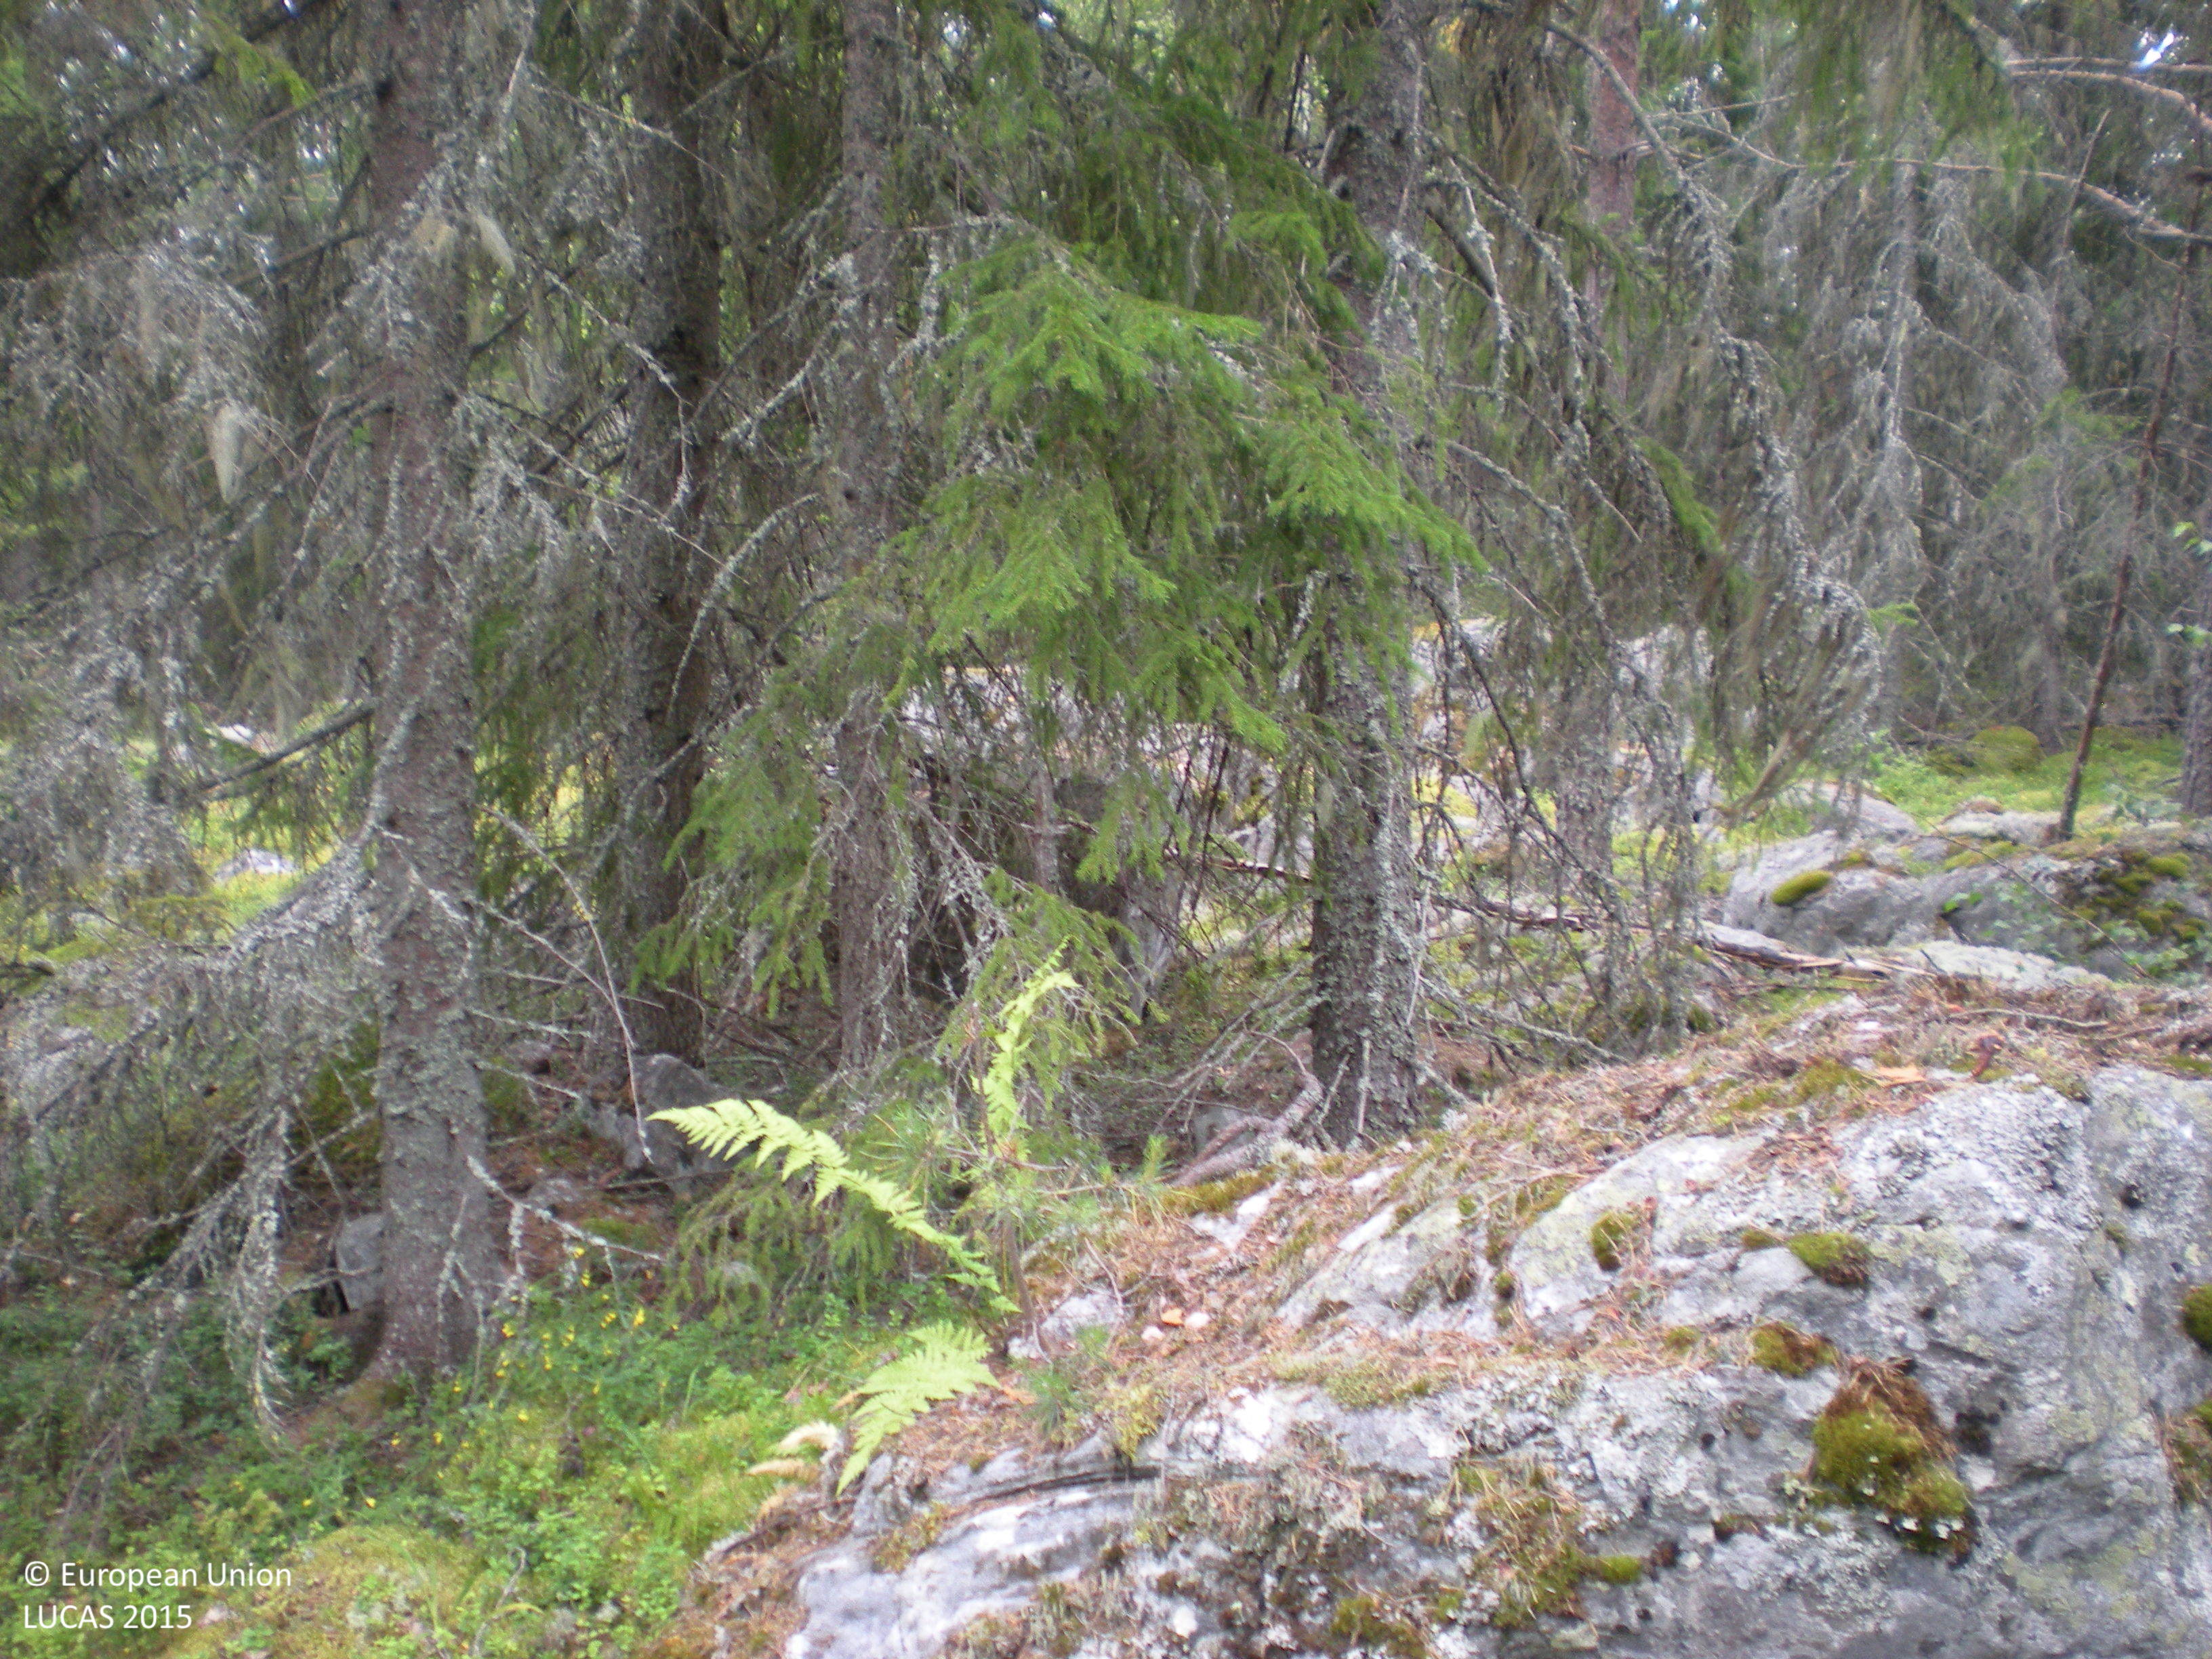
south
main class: Woodland
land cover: Other coniferous woodland
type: boreal forest
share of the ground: 50 - 75 %
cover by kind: coniferous forest trees 65 %, consolidated bare surface 15 %, shrubs 10 %, herbaceous plants 5 %, lichens and mosses 5 %
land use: Forestry
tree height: > 5 m
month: August
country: SE
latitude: 60.8119
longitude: 17.1760
